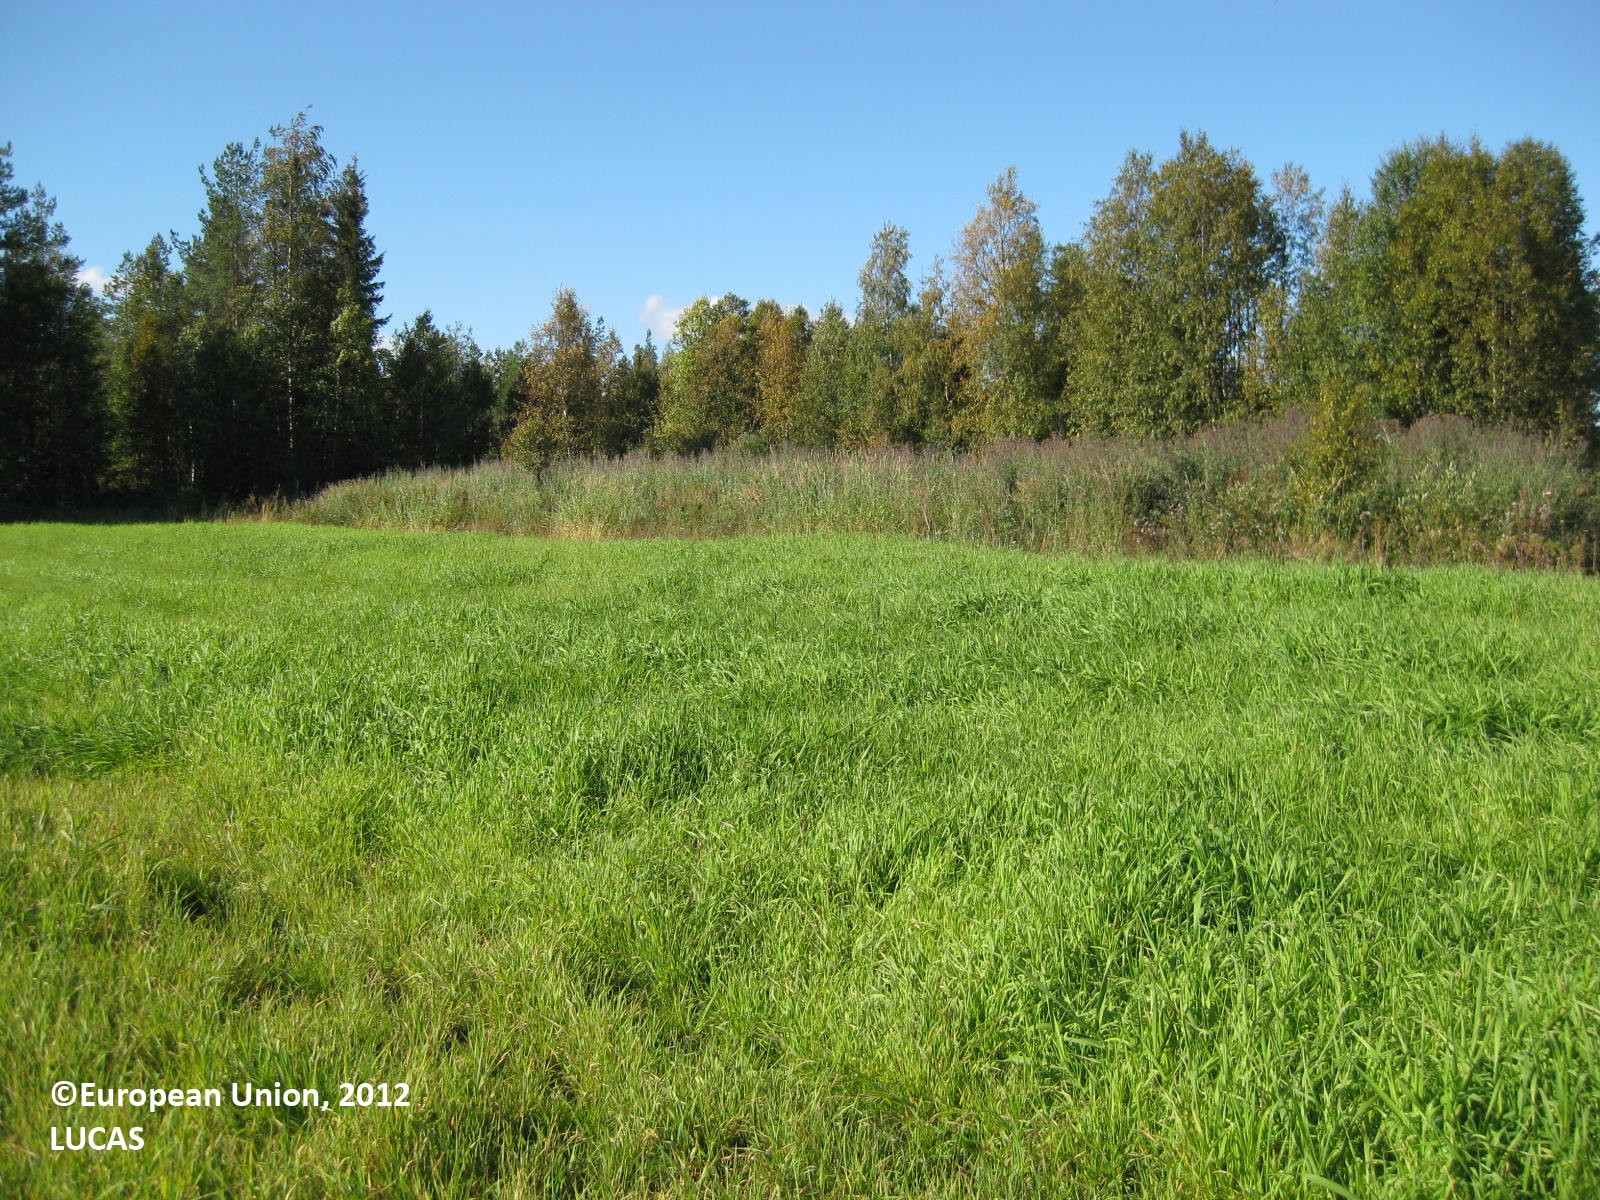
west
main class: Cropland
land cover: Temporary grasslands
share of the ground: > 75 %
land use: Agriculture (excluding fallow land and kitchen gardens)
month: August
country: FI
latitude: 66.0268
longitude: 29.7644
